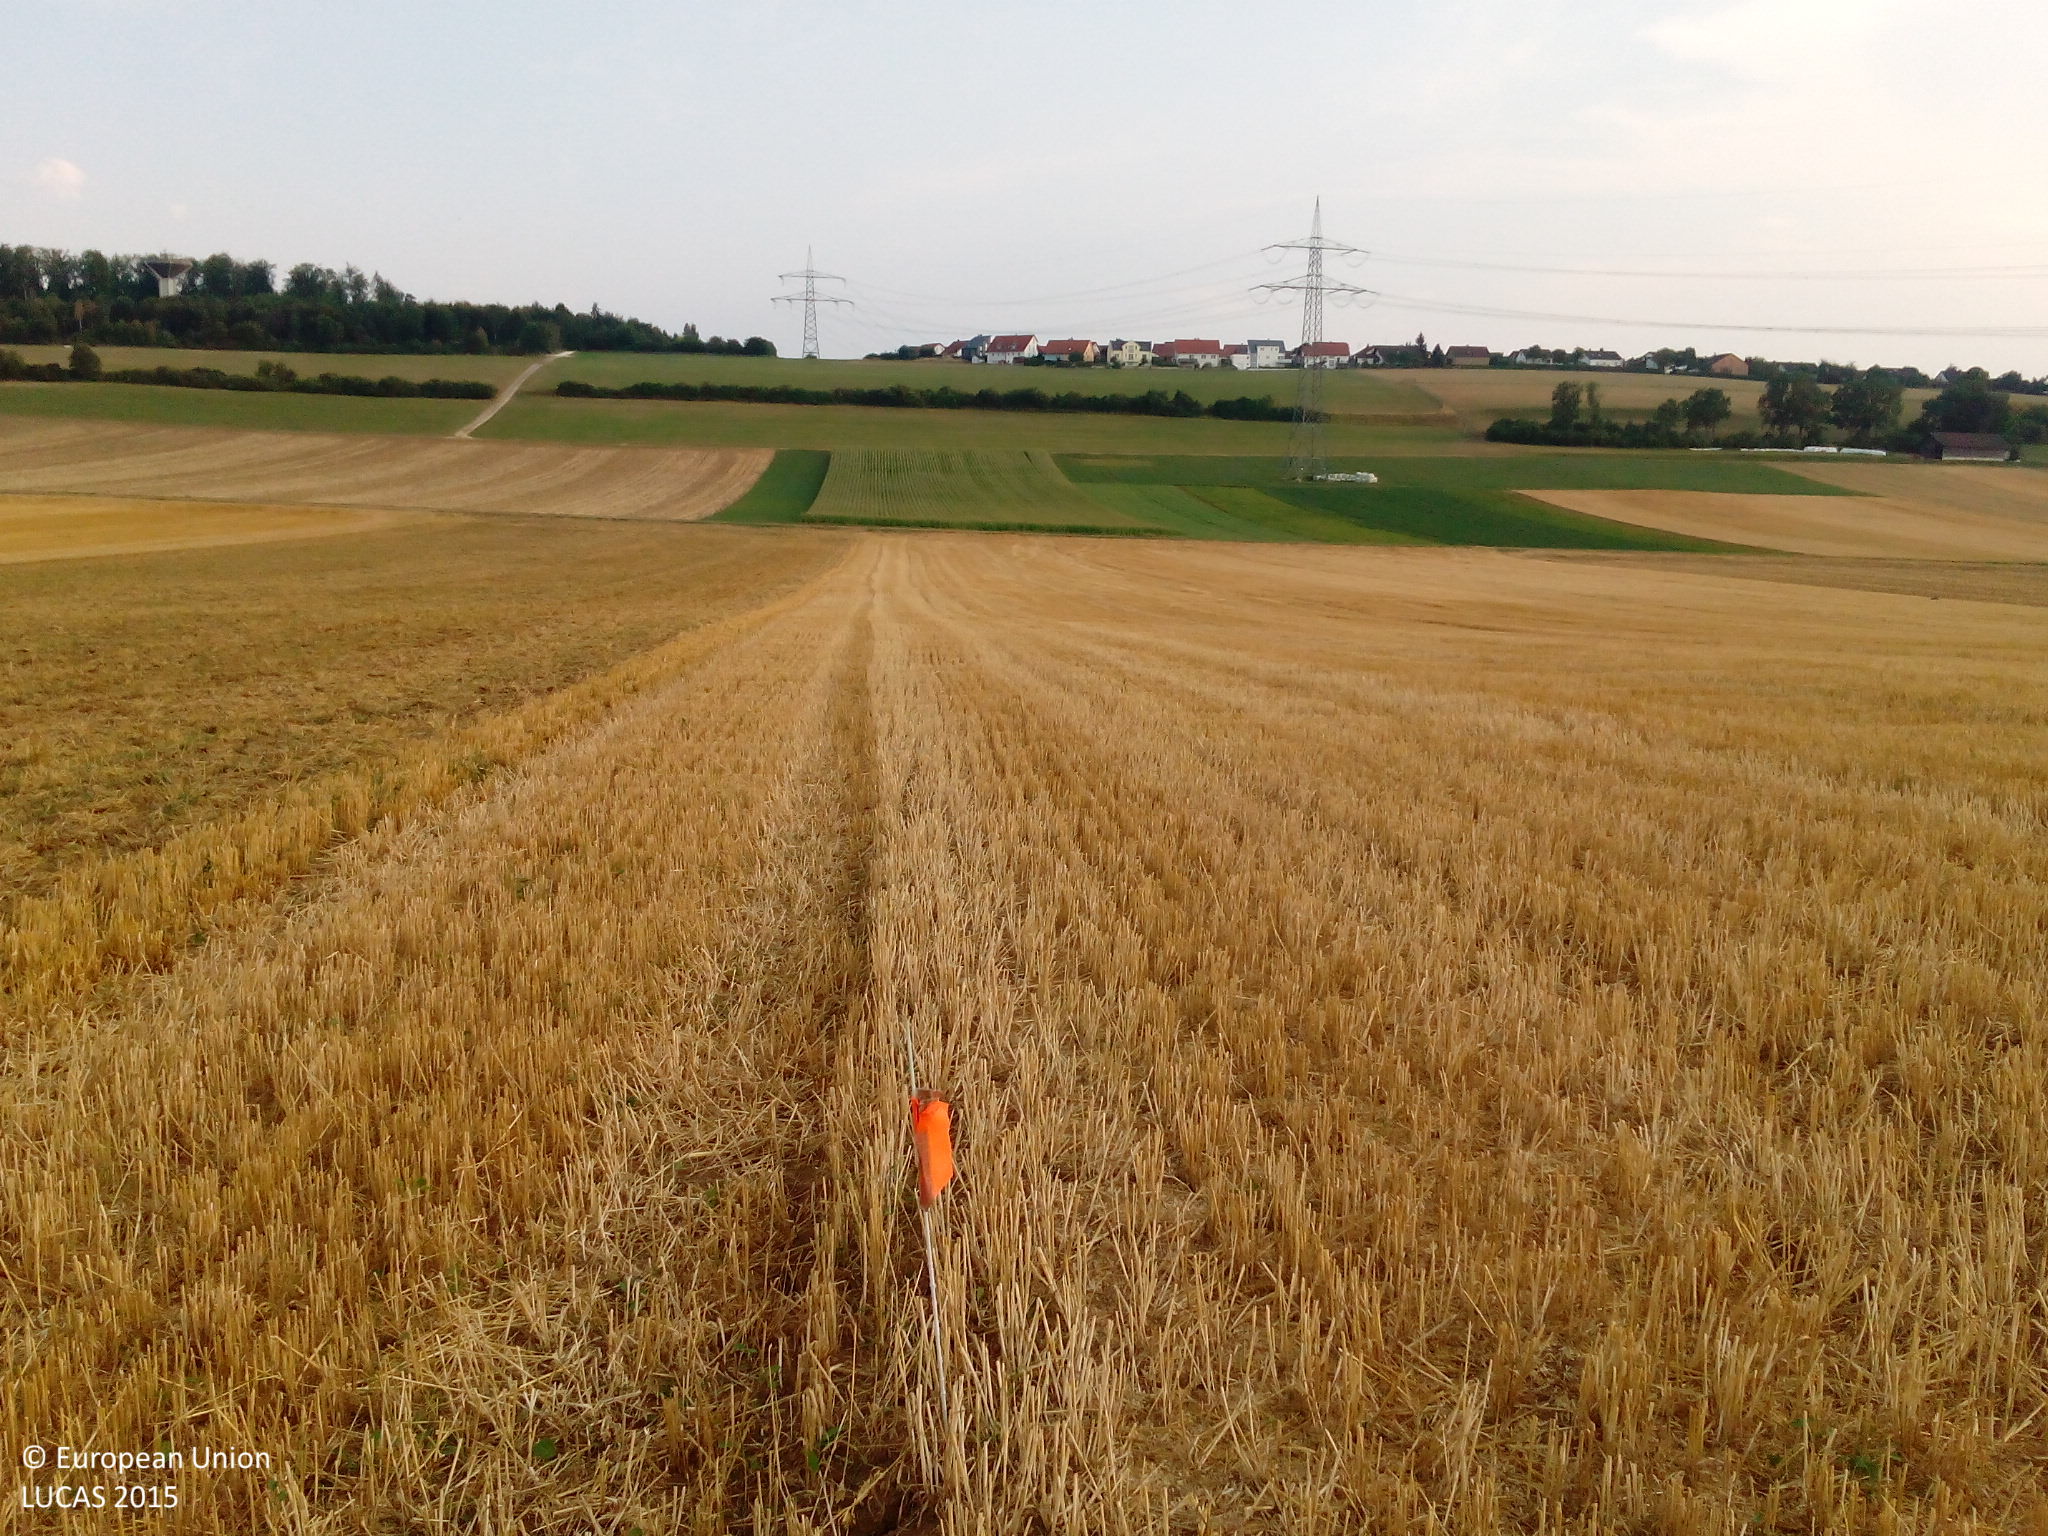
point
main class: Cropland
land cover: Common wheat
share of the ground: > 75 %
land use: Agriculture (excluding fallow land and kitchen gardens)
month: August
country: DE
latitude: 48.7090
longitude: 10.2581
